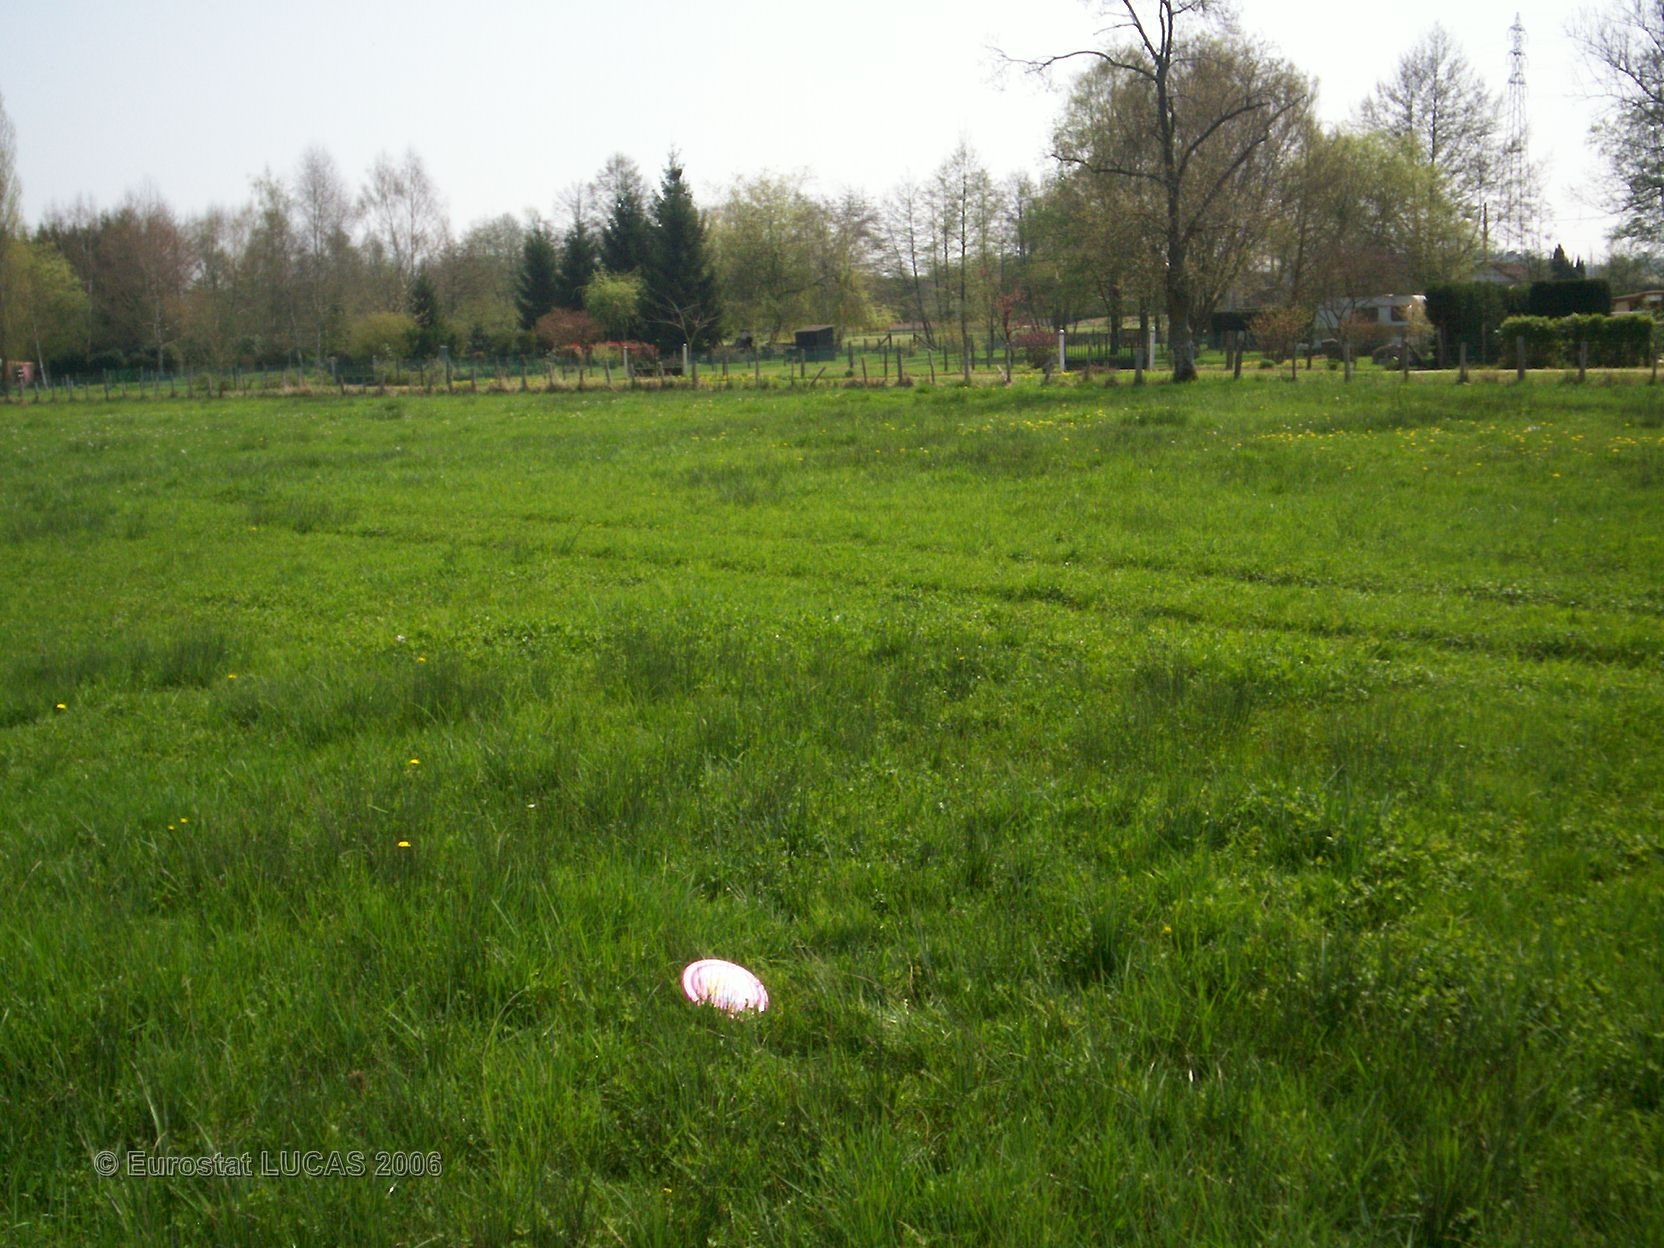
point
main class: Grassland
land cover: Grassland without tree/shrub cover
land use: Agriculture (excluding fallow land and kitchen gardens)
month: April
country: FR
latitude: 48.0380
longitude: 0.3857
